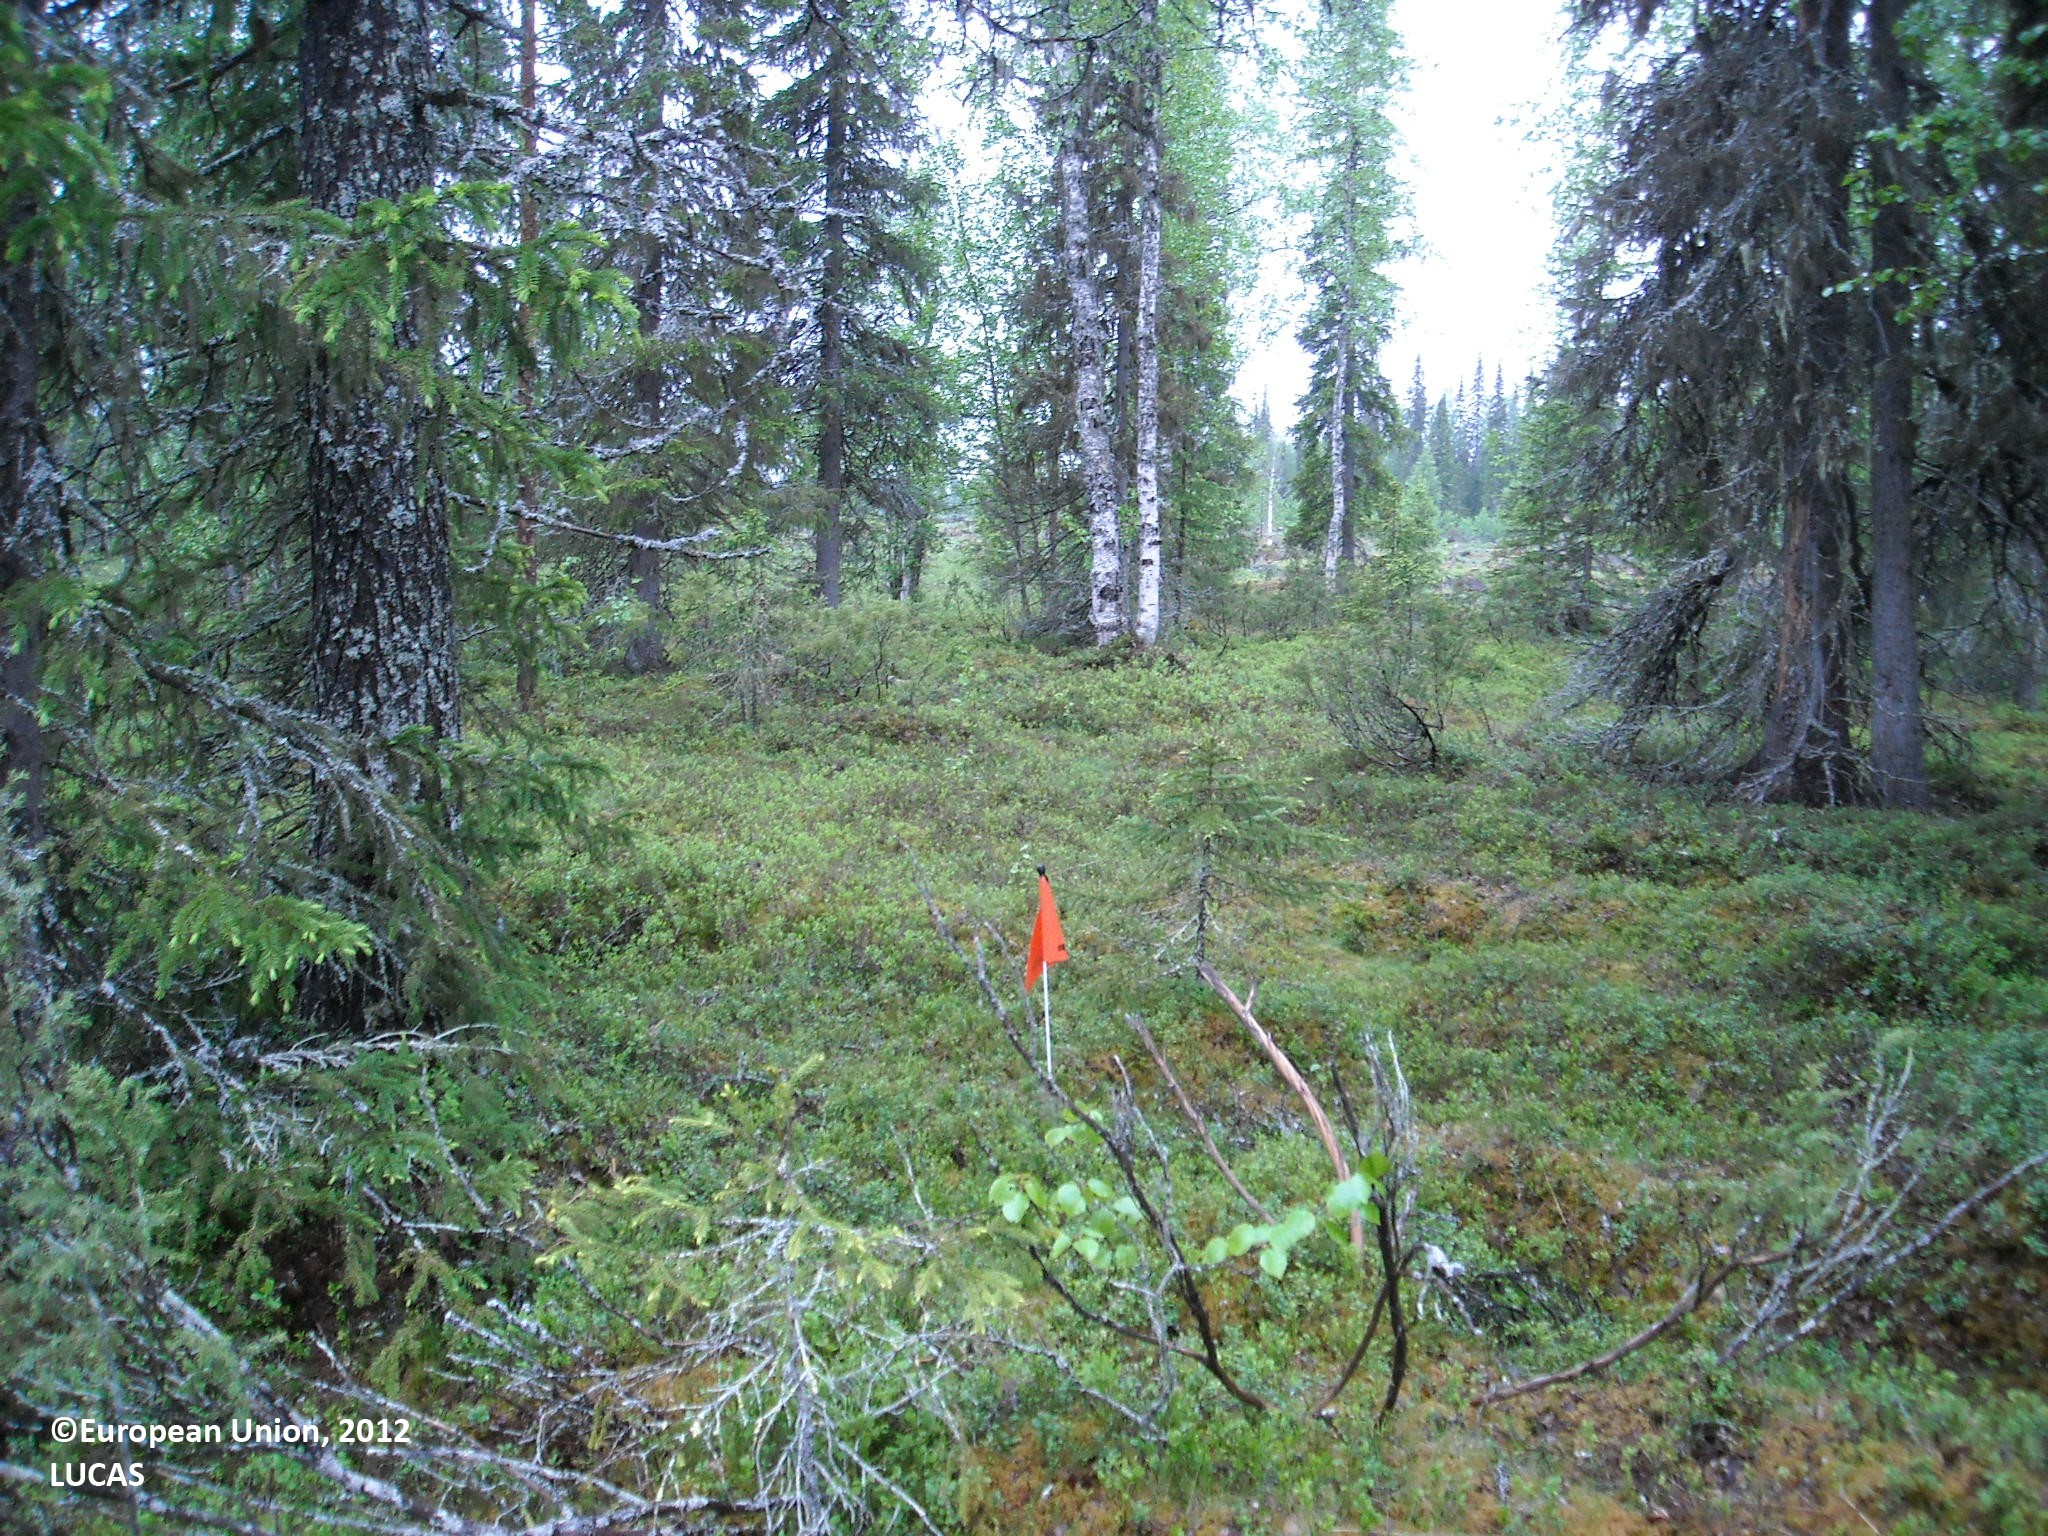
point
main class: Woodland
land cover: Spruce dominated mixed woodland
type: mire and swamp forests
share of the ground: 50 - 75 %
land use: Forestry
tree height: > 5 m
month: June
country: FI
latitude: 65.6290
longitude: 28.0178
